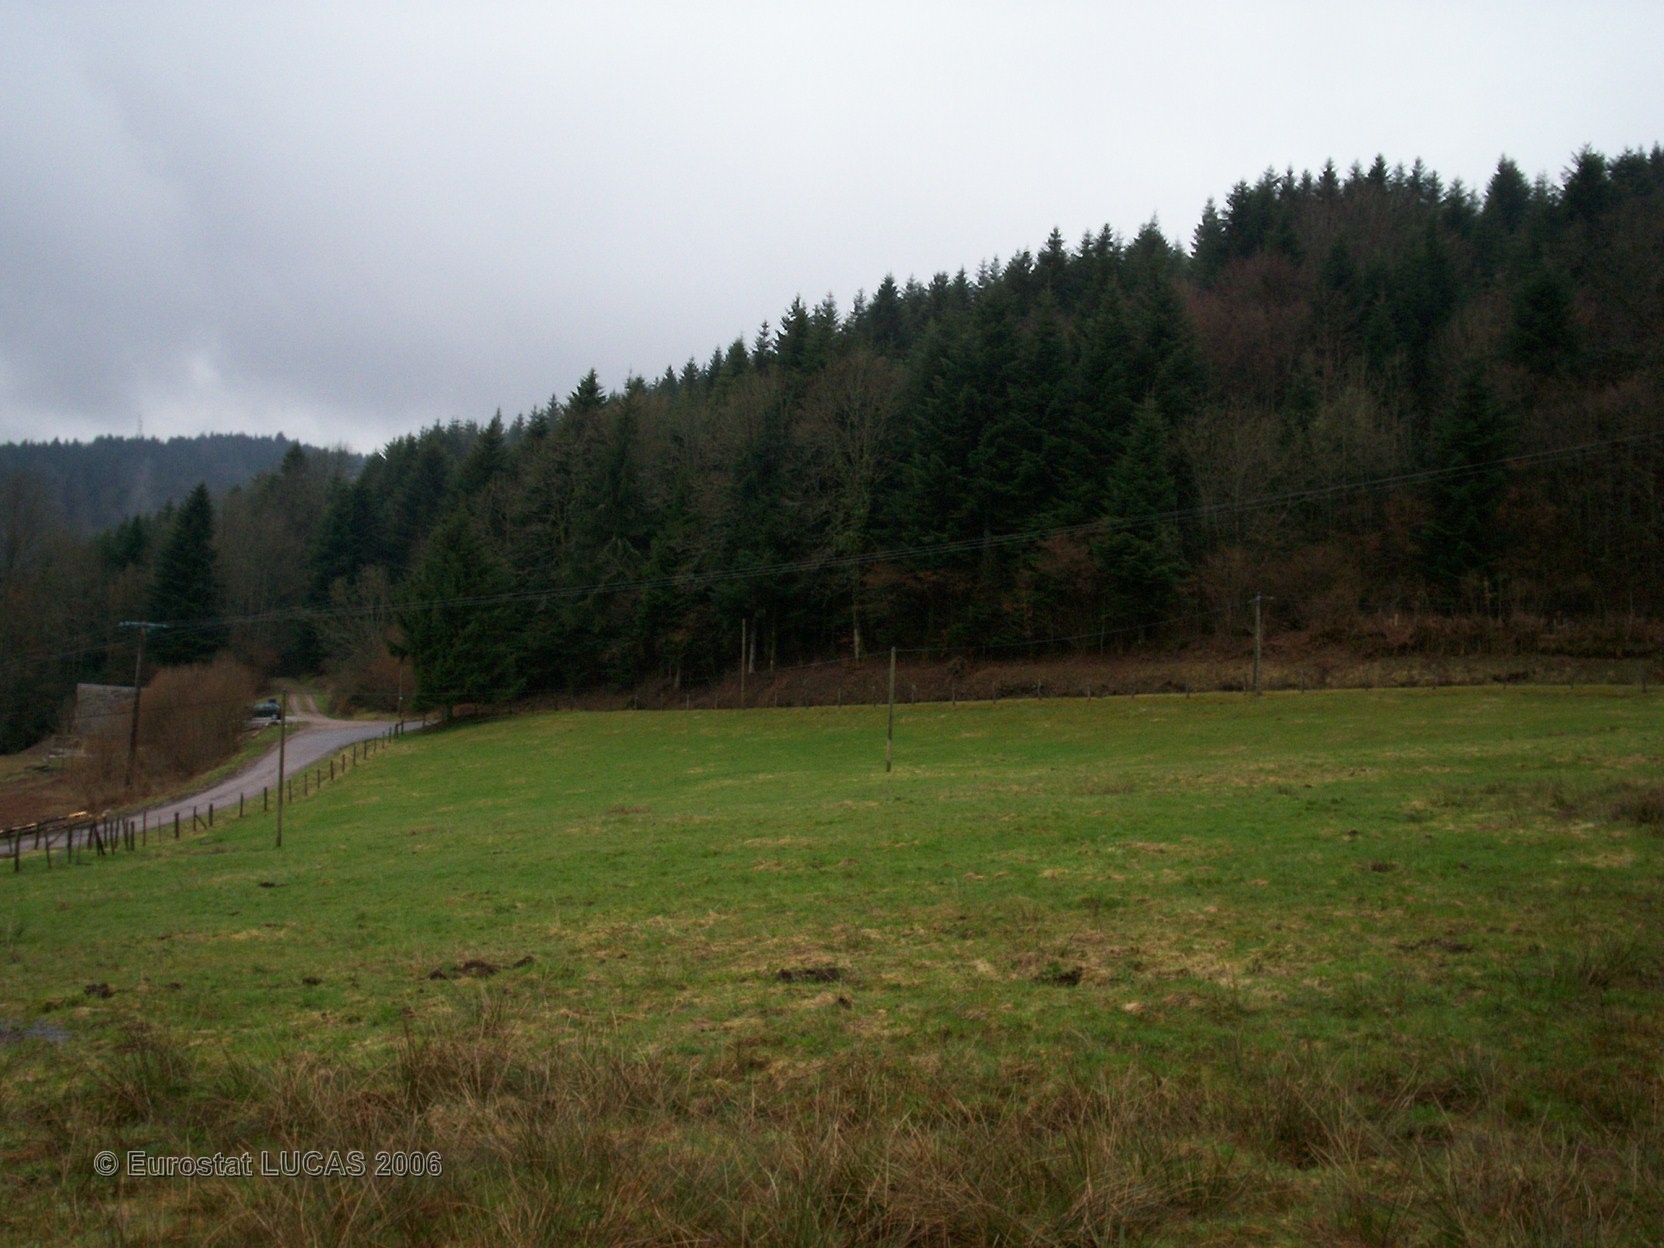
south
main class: Grassland
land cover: Grassland without tree/shrub cover
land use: Agriculture (excluding fallow land and kitchen gardens)
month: April
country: FR
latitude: 47.9734
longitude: 6.6119
